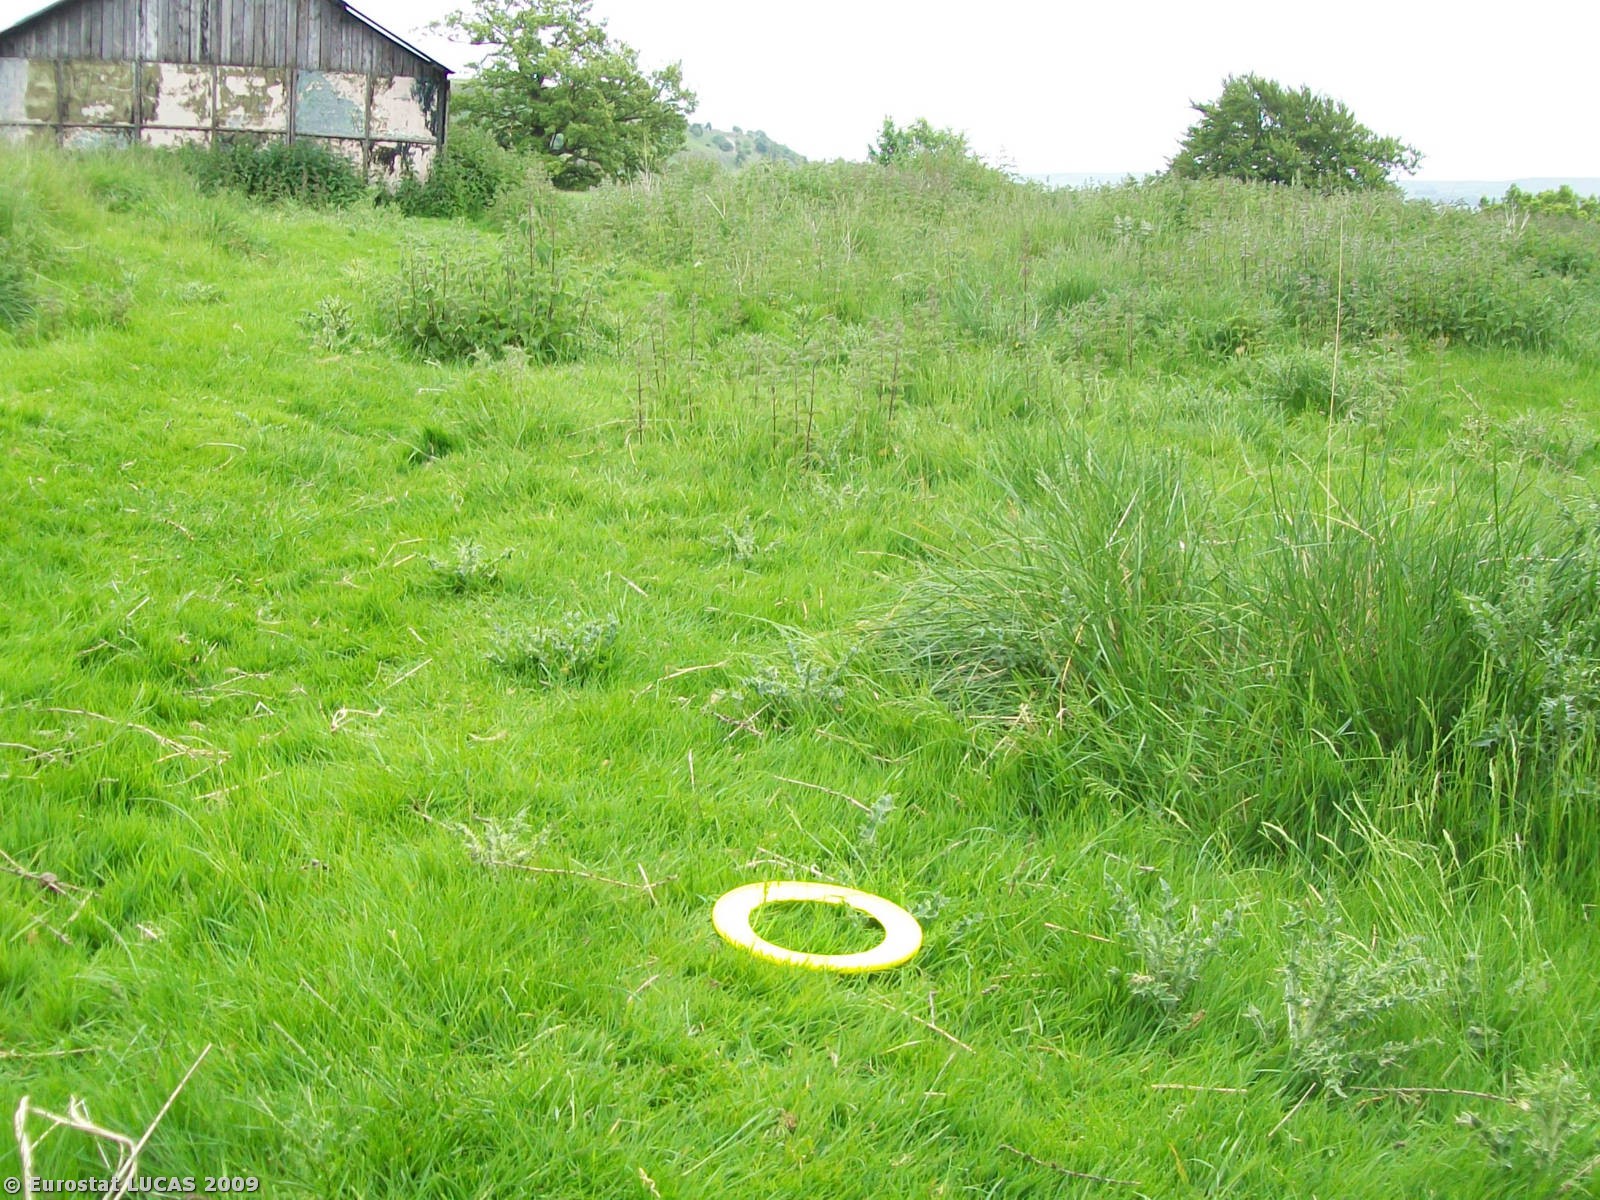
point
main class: Grassland
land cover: Grassland without tree/shrub cover
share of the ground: > 75 %
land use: Agriculture (excluding fallow land and kitchen gardens)
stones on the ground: < 10 %
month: June
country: GB
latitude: 54.7486
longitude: -2.0023
